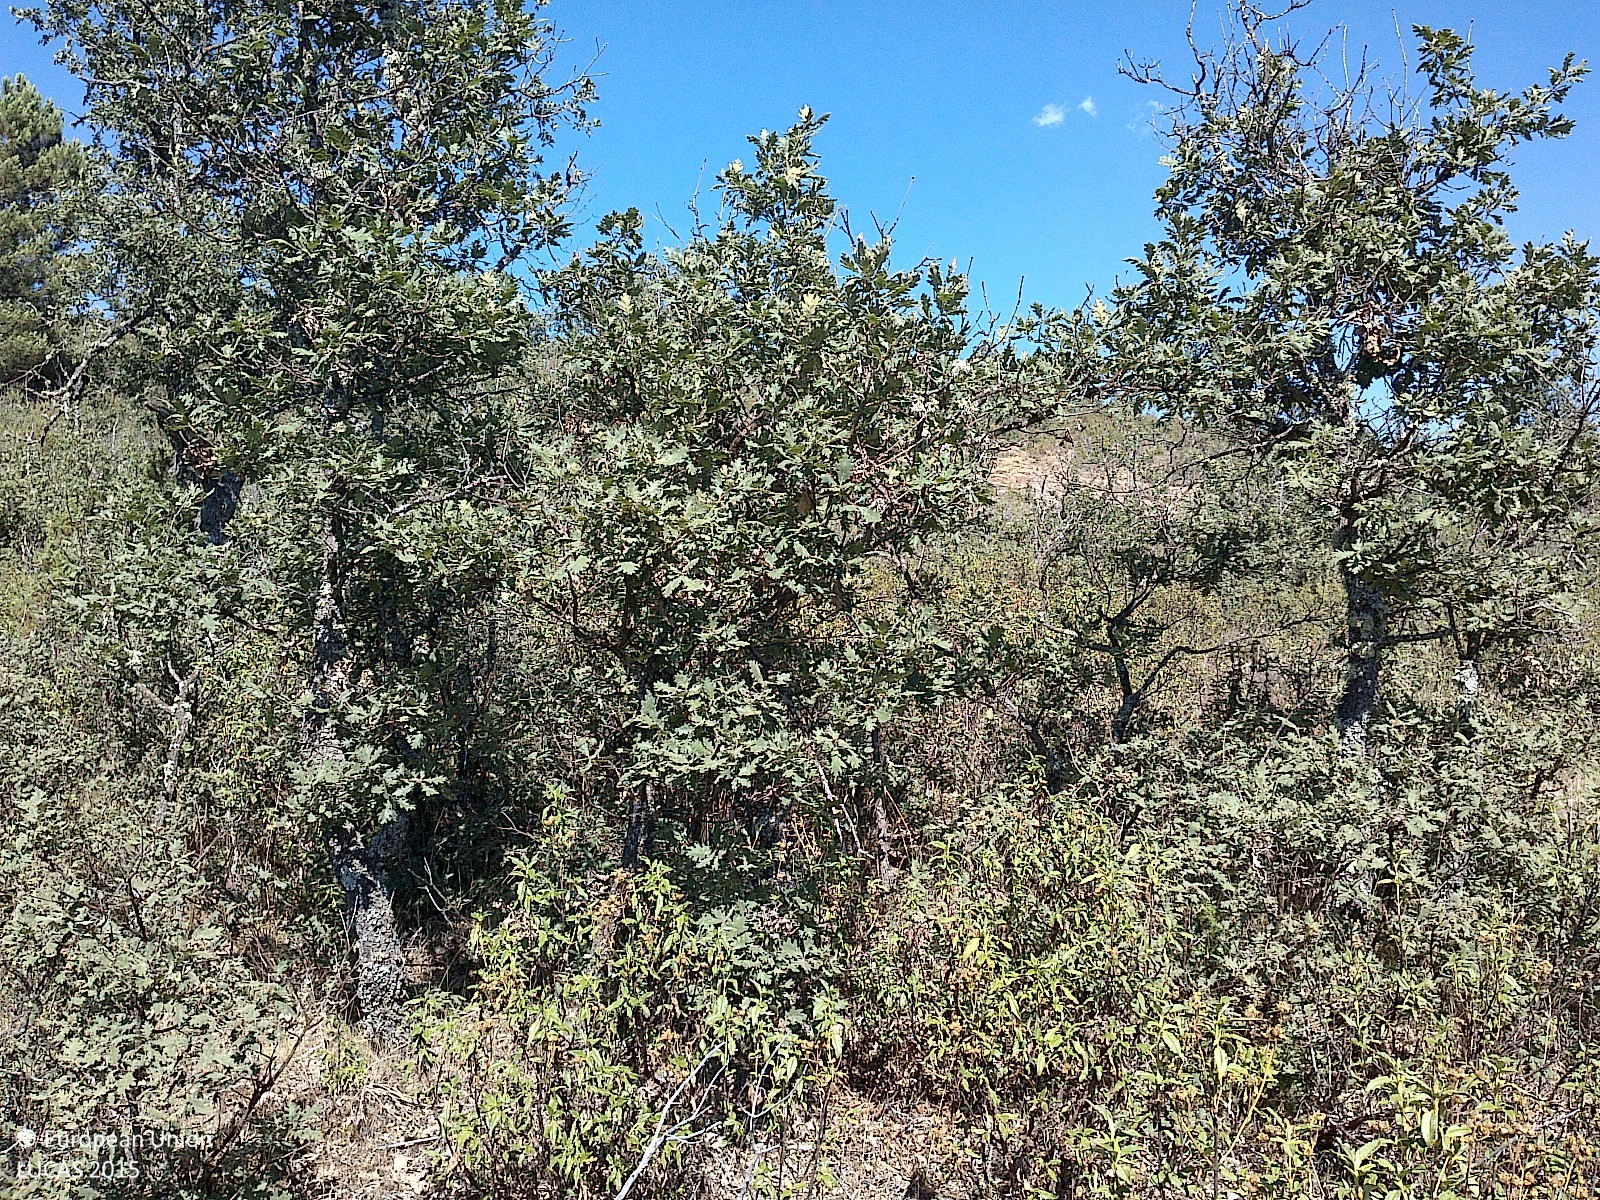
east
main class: Woodland
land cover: Broadleaved woodland
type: thermophilous deciduous forest
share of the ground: 10 - 25 %
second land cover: Grassland without tree/shrub cover
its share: 25 - 50 %
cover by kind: shrubs 55 %, herbaceous plants 25 %, broadleaved forest trees 20 %
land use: Forestry
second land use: Agriculture (excluding fallow land and kitchen gardens)
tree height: < 5 m
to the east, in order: Broadleaved woodland; Grassland without tree/shrub cover; Shrubland without tree cover; Grassland with sparse tree/shrub cover; Broadleaved woodland
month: July
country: ES
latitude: 41.9218
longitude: -3.2775
